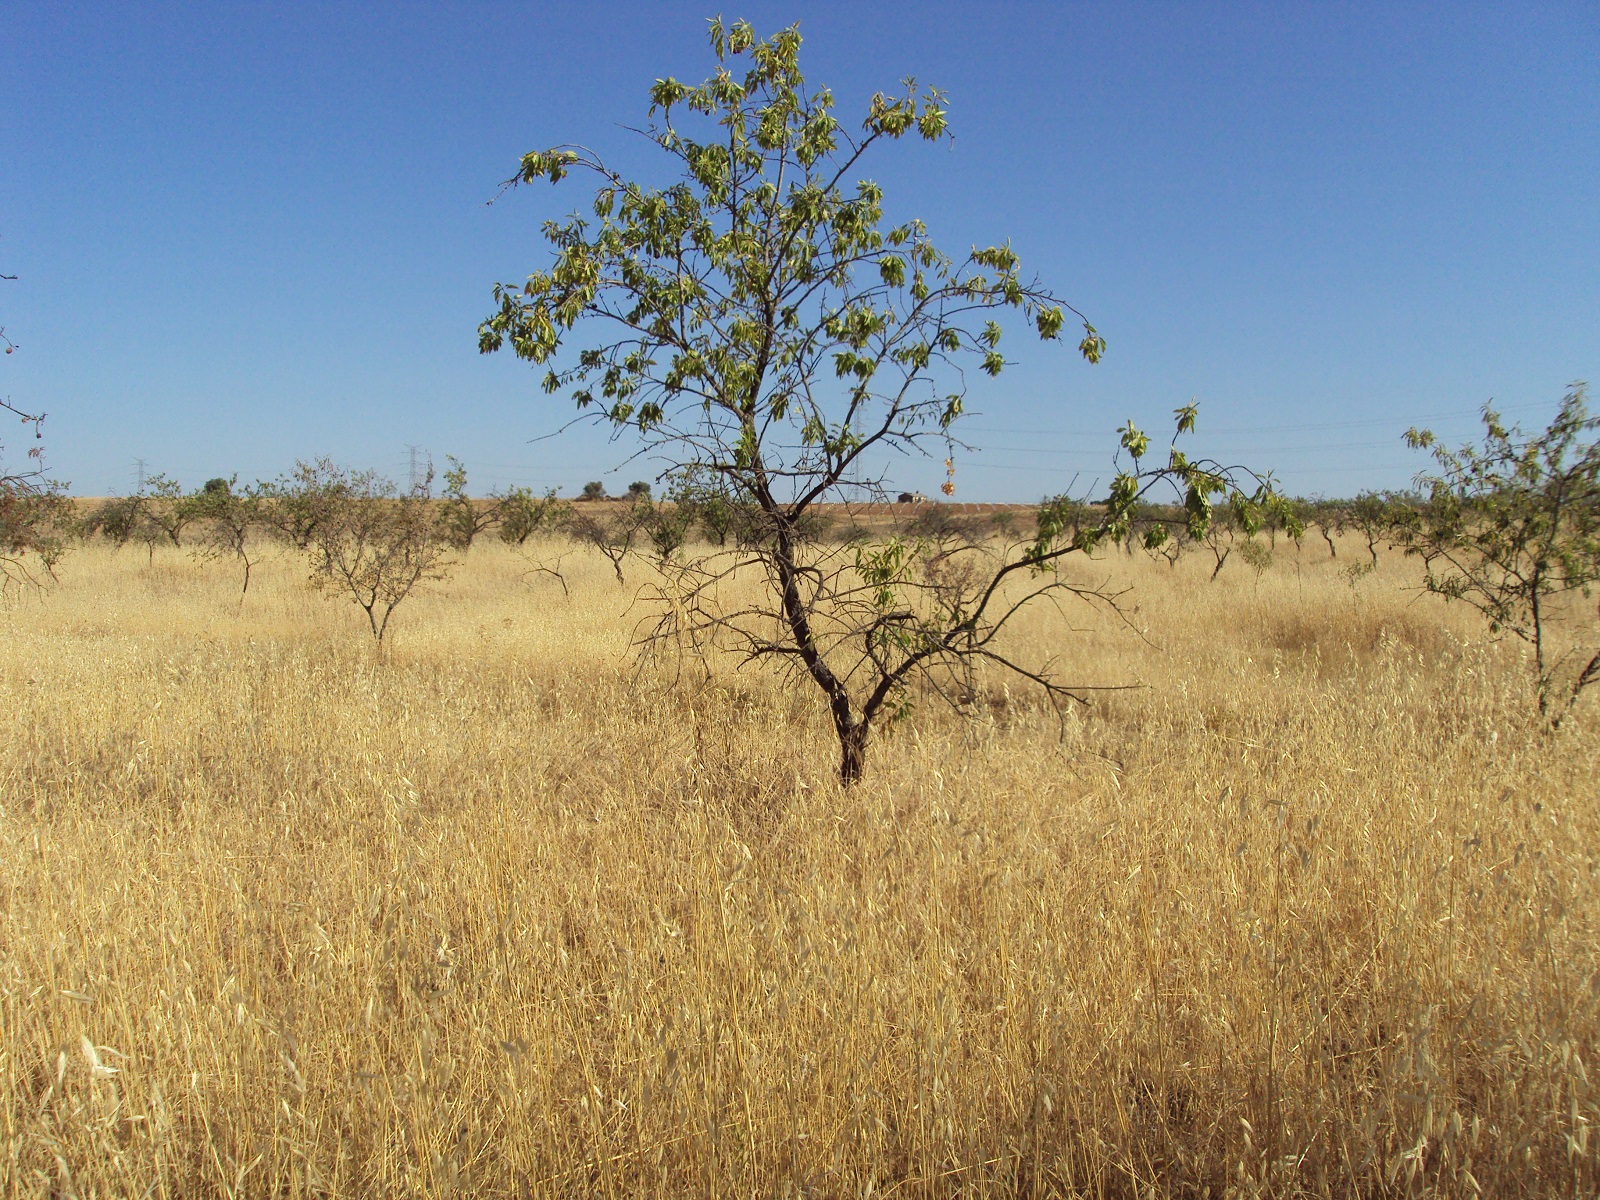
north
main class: Cropland
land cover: Nuts trees
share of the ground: 25 - 50 %
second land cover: Spontaneously vegetated surfaces
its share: > 75 %
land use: Agriculture (excluding fallow land and kitchen gardens)
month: June
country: ES
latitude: 37.4000
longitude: -6.9290
